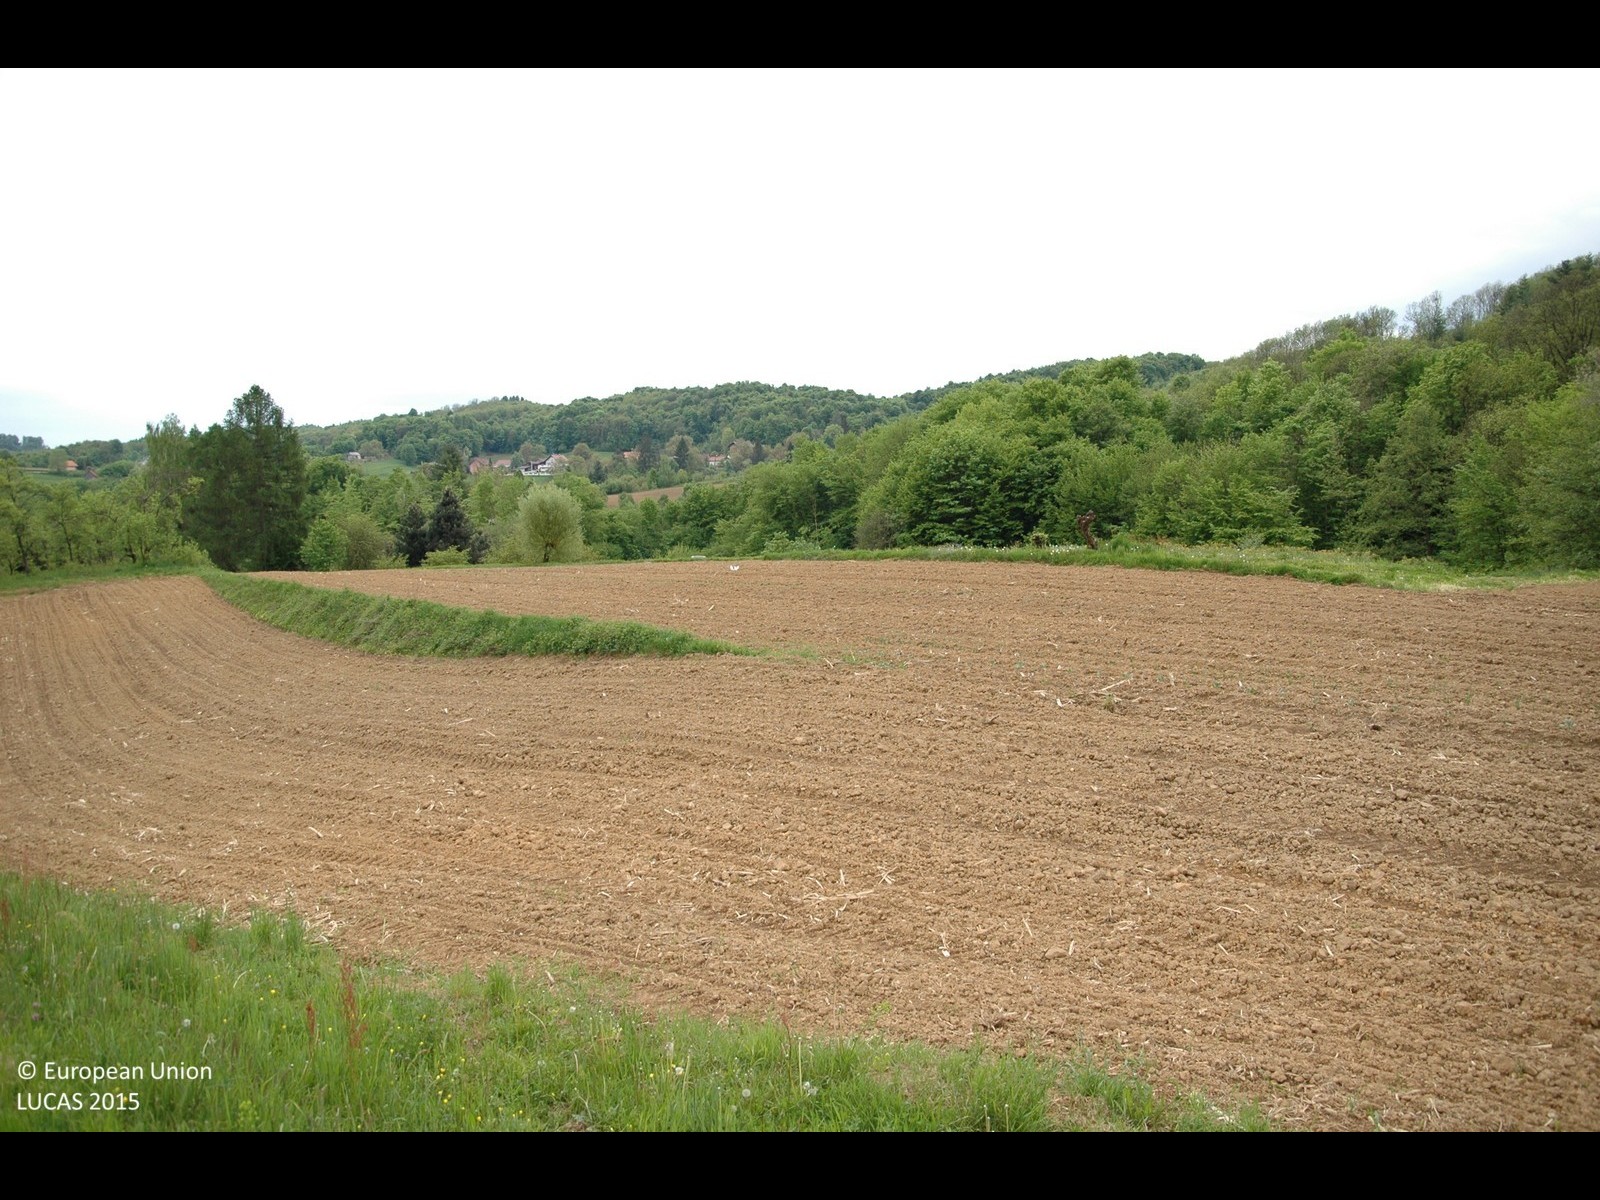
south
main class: Grassland
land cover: Grassland with sparse tree/shrub cover
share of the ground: > 75 %
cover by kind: herbaceous plants 90 %, broadleaved forest trees 5 %, shrubs 5 %
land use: Agriculture (excluding fallow land and kitchen gardens)
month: May
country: HR
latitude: 45.8214
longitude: 15.6735
